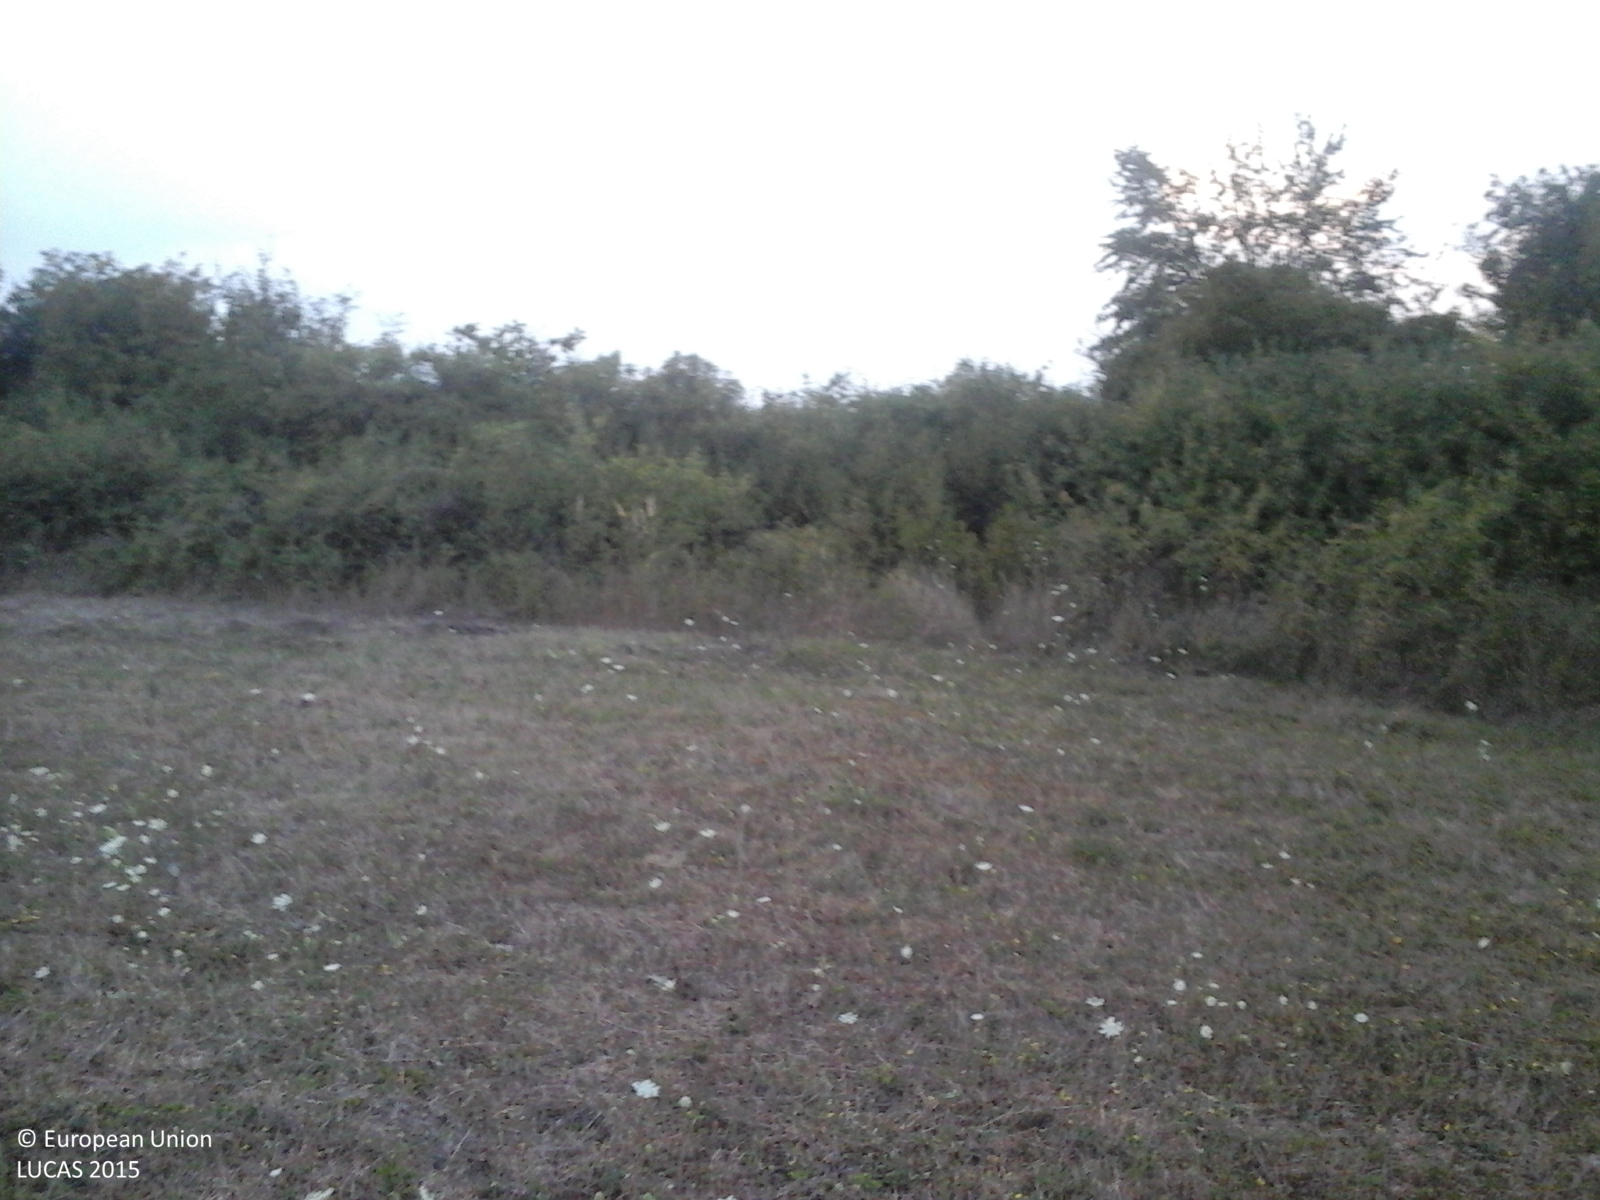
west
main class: Grassland
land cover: Grassland without tree/shrub cover
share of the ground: > 75 %
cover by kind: herbaceous plants 100 %
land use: Agriculture (excluding fallow land and kitchen gardens)
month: August
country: RO
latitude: 44.6801
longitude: 23.1316
